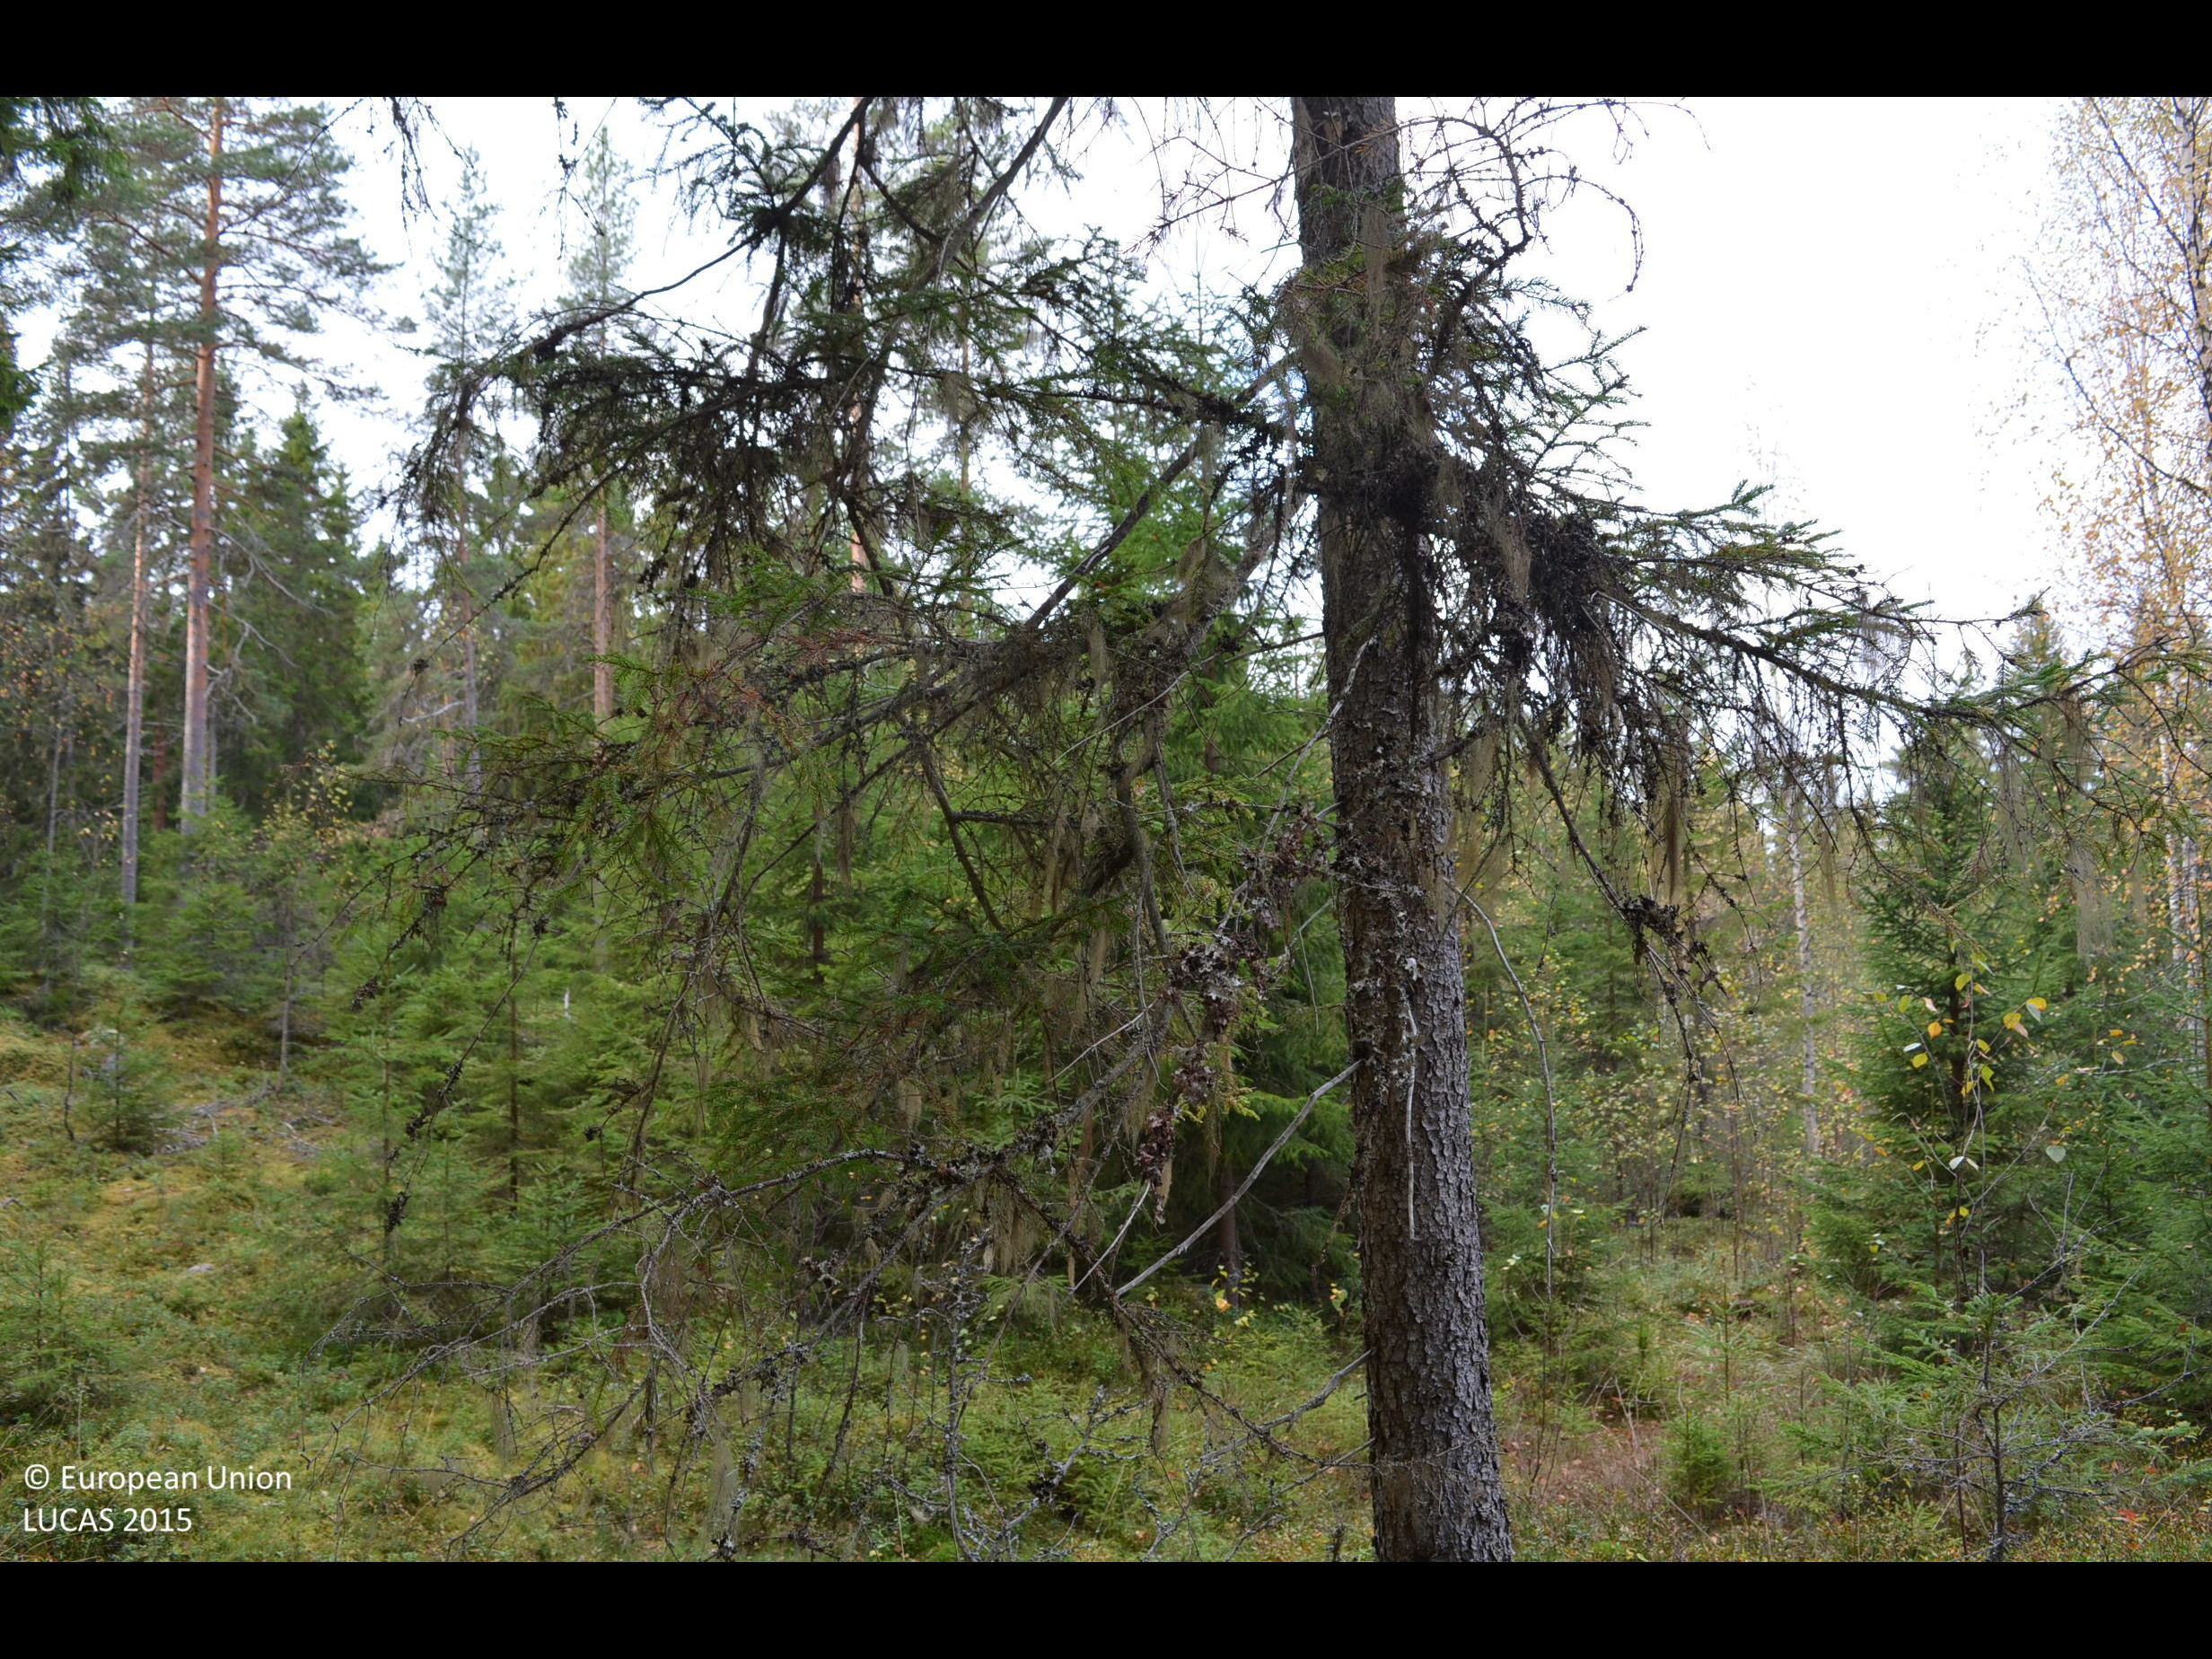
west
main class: Woodland
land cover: Other coniferous woodland
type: boreal forest
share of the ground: > 75 %
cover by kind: coniferous forest trees 70 %, lichens and mosses 15 %, shrubs 10 %, broadleaved forest trees 5 %
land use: Forestry
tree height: > 5 m
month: October
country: FI
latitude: 61.6703
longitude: 23.8938
